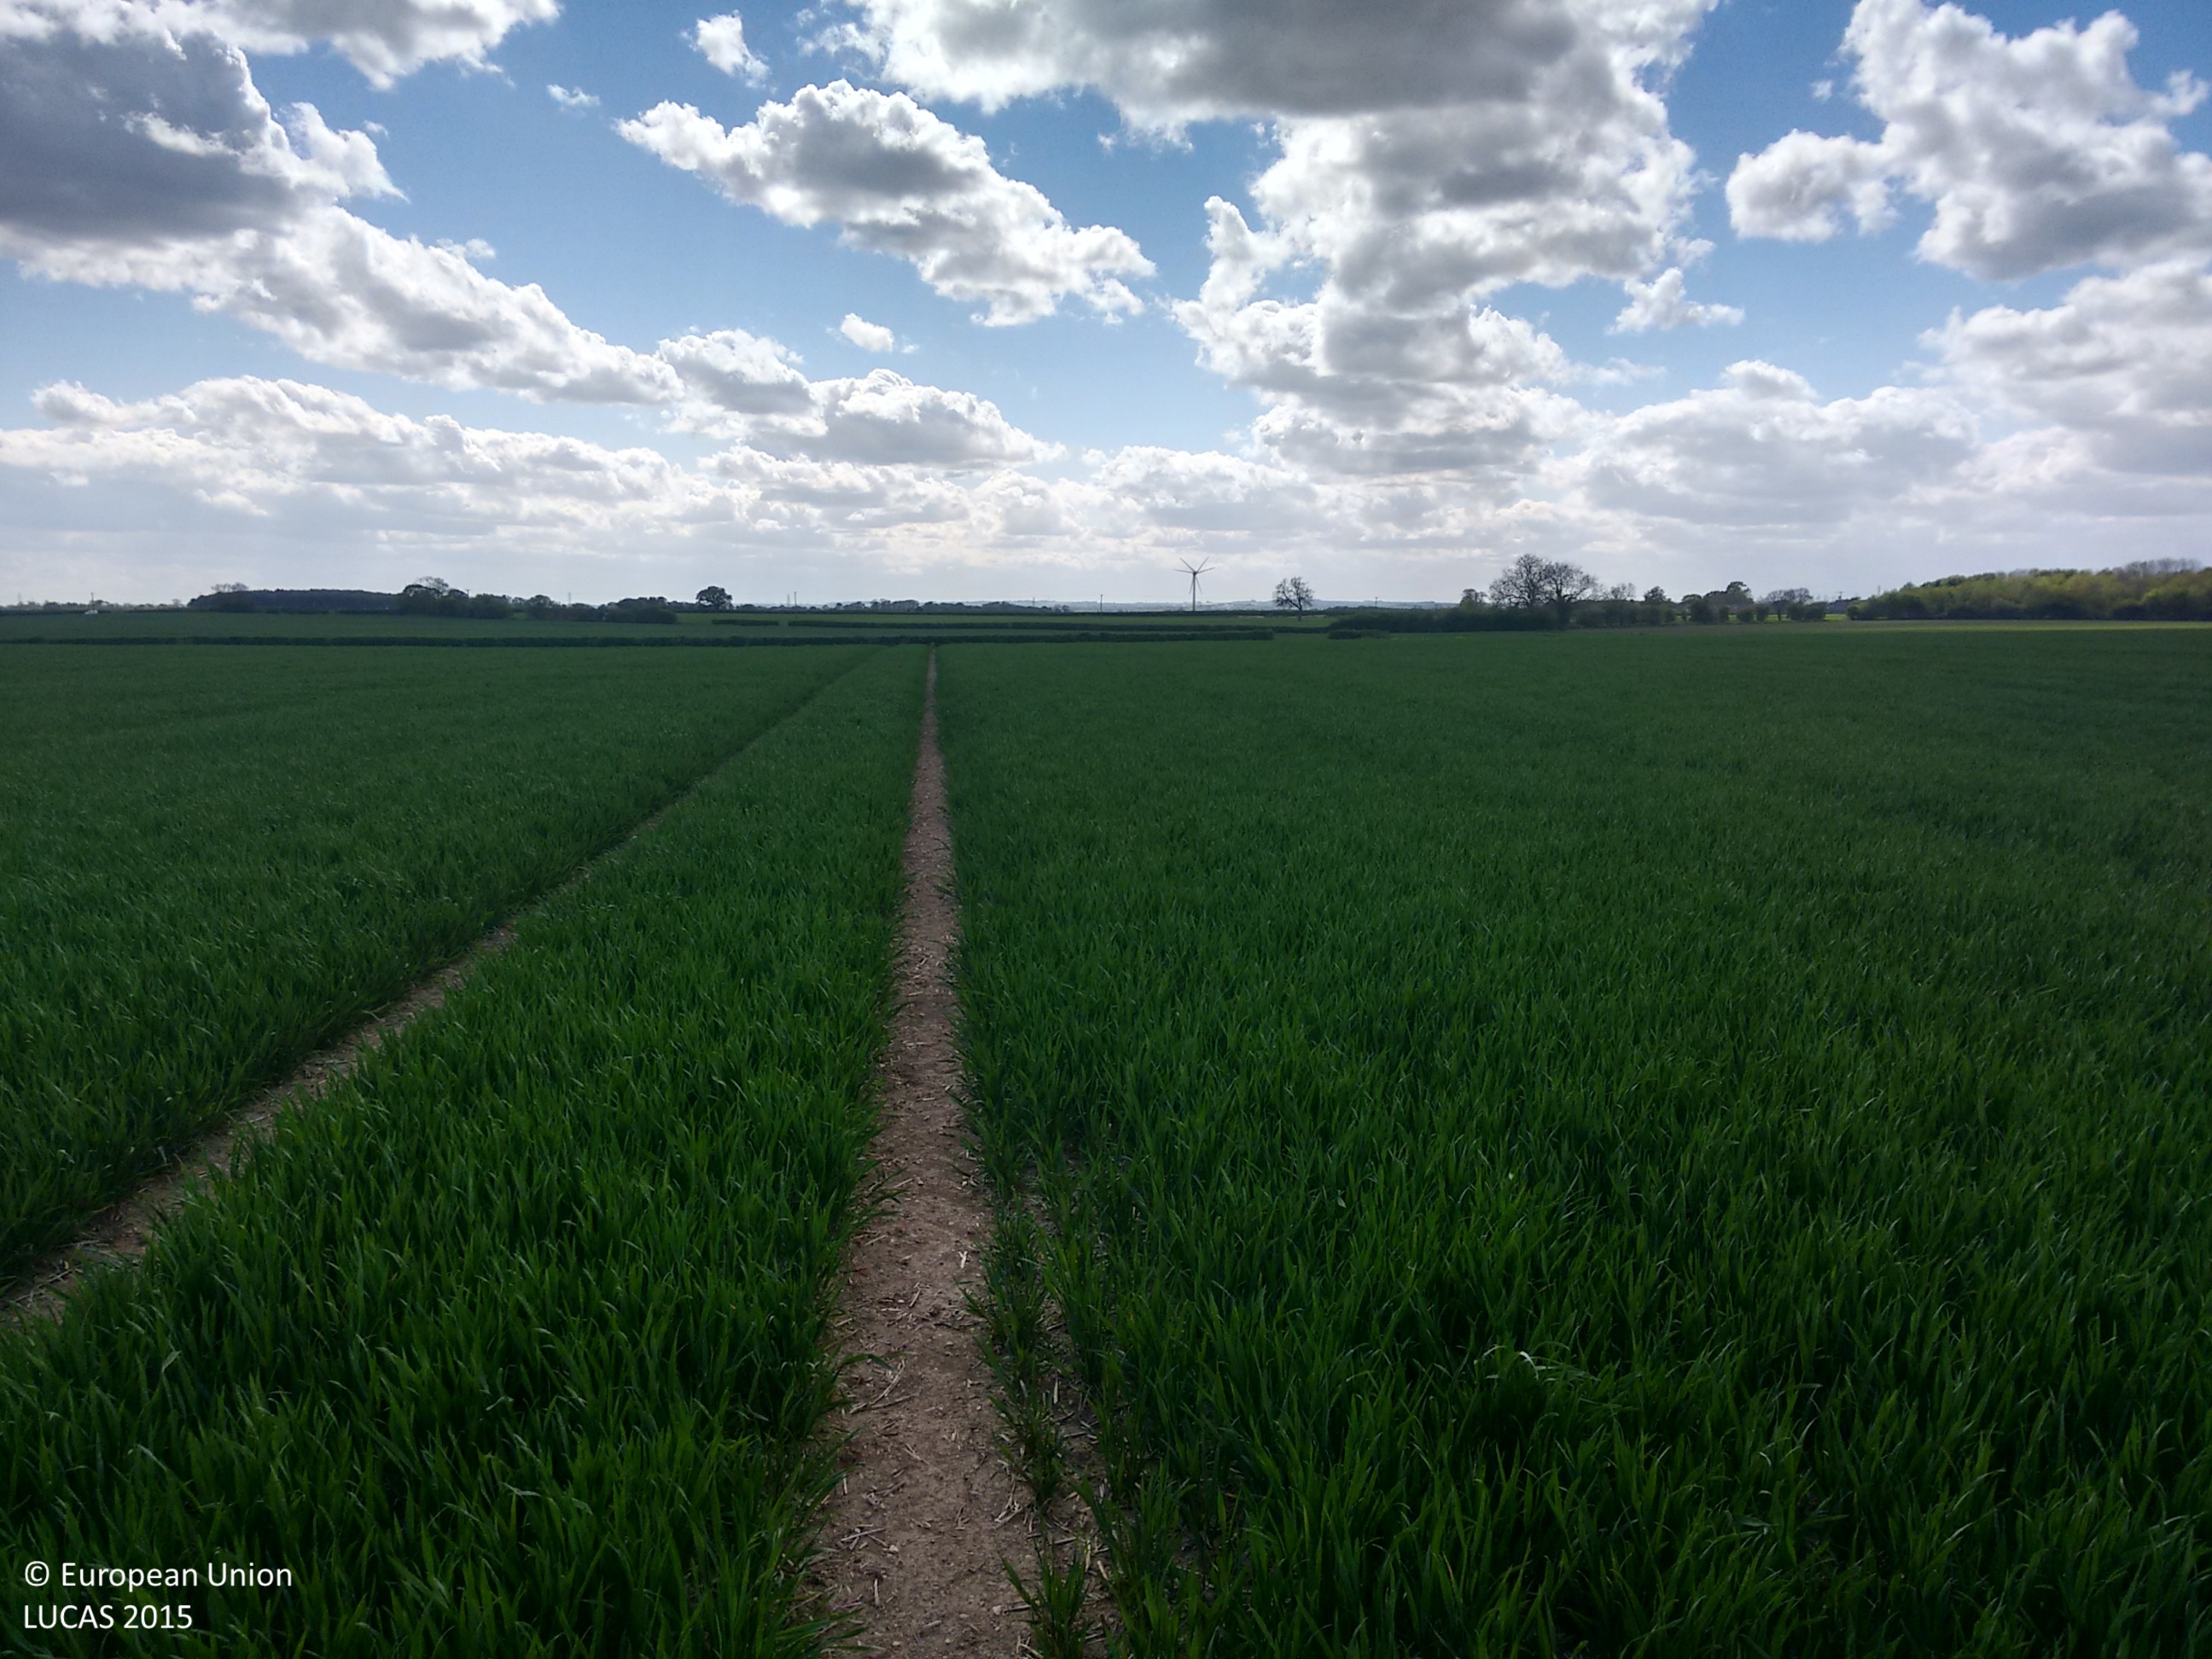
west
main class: Cropland
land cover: Common wheat
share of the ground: > 75 %
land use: Agriculture (excluding fallow land and kitchen gardens)
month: May
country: GB
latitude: 53.8655
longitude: -0.3297
